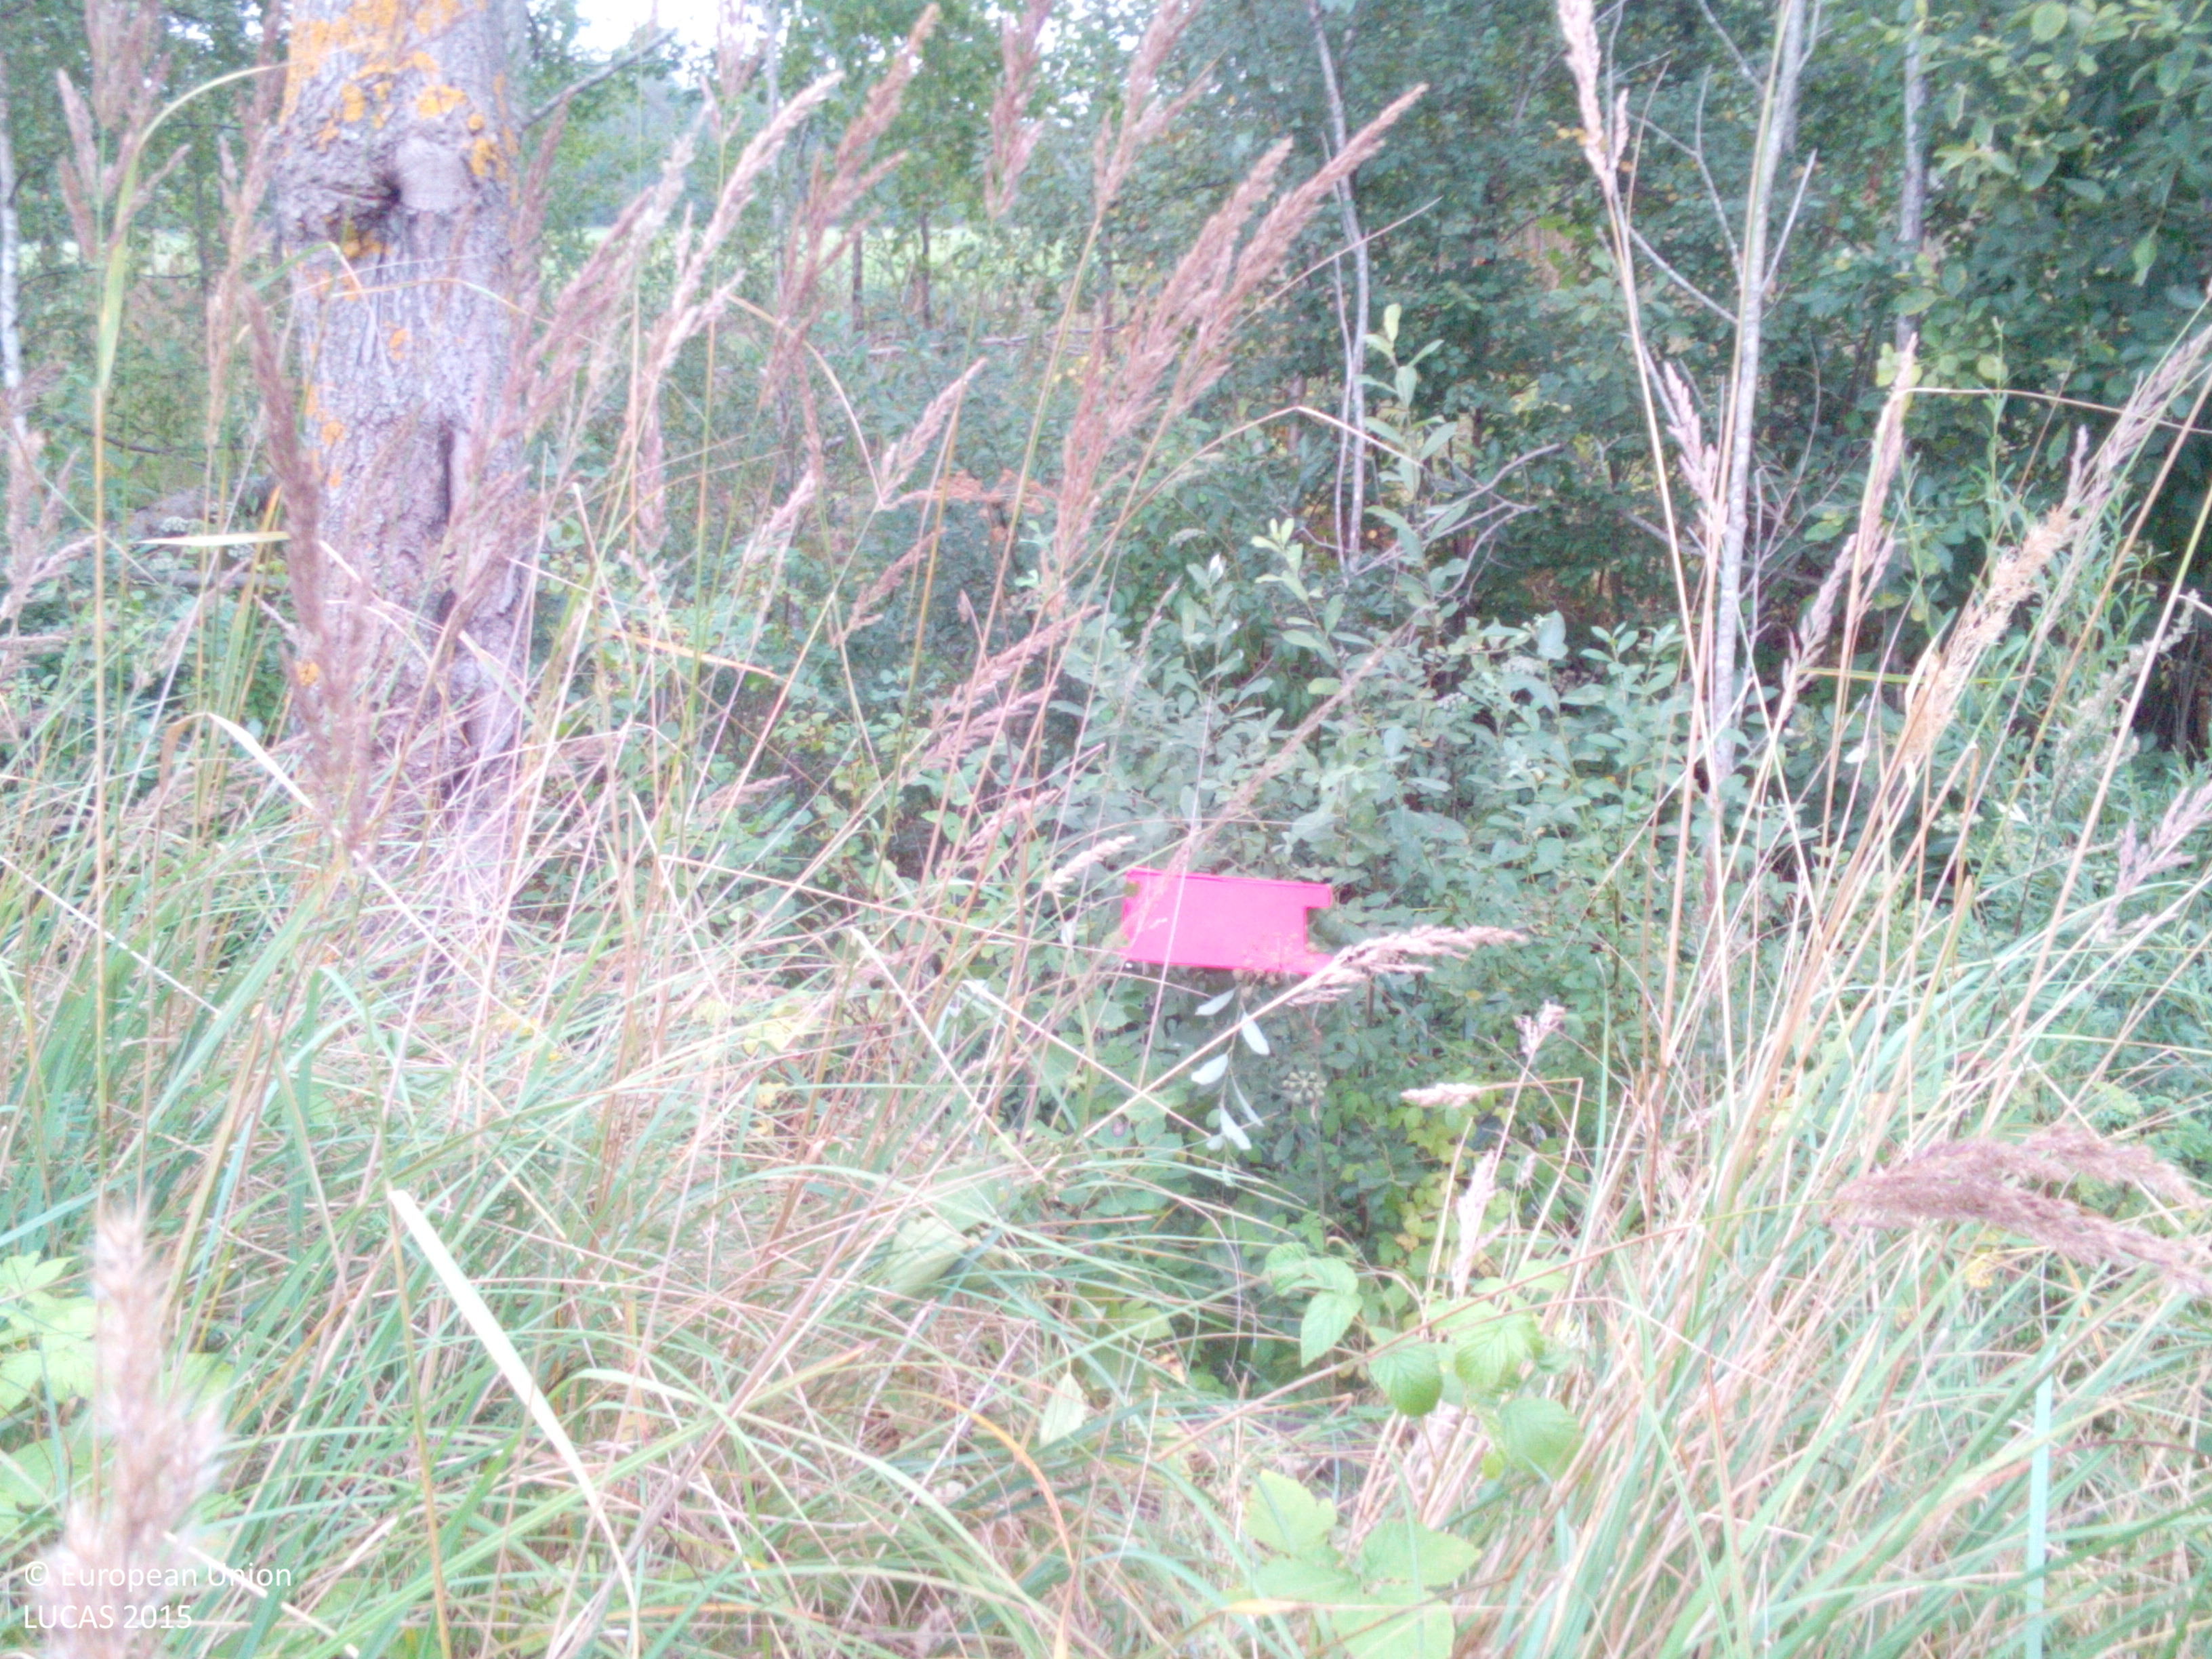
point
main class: Woodland
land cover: Broadleaved woodland
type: non-riverine alder, birch or aspen forest
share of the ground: 25 - 50 %
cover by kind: herbaceous plants 60 %, broadleaved forest trees 40 %
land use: Forestry
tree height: > 5 m
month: August
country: LV
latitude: 56.2064
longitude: 21.1786
